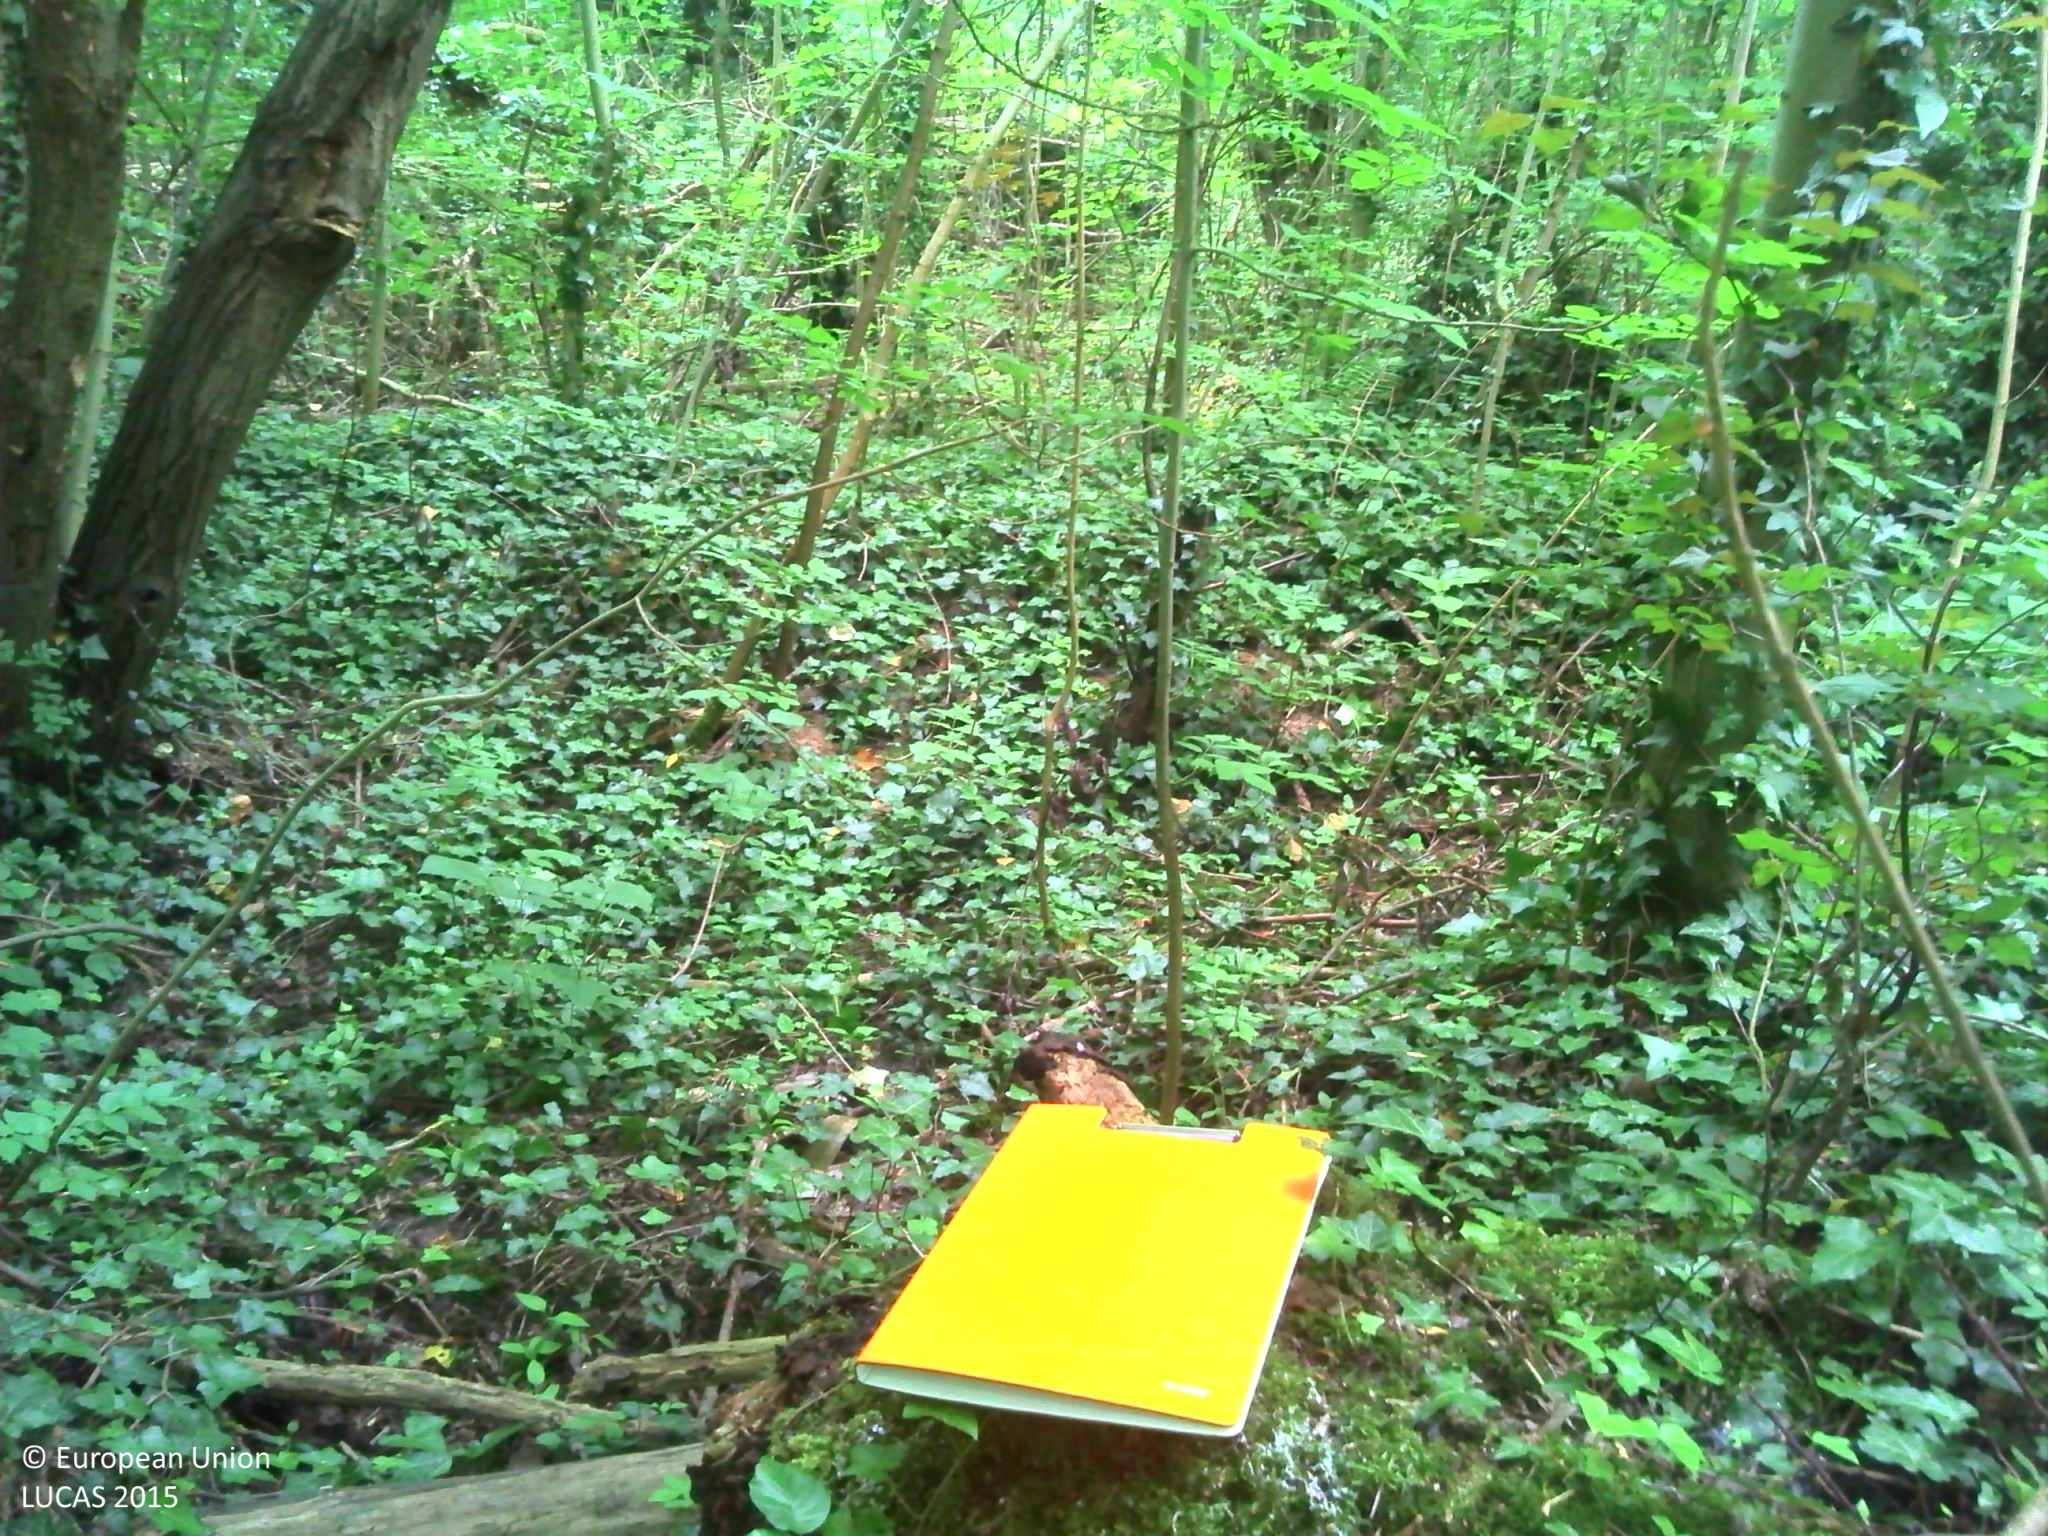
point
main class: Woodland
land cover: Broadleaved woodland
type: acidophilous oak and oak-birch forest
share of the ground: > 75 %
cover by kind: broadleaved forest trees 75 %, herbaceous plants 15 %, coniferous forest trees 10 %
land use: Forestry
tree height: > 5 m
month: June
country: BE
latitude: 50.8624
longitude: 4.4974
